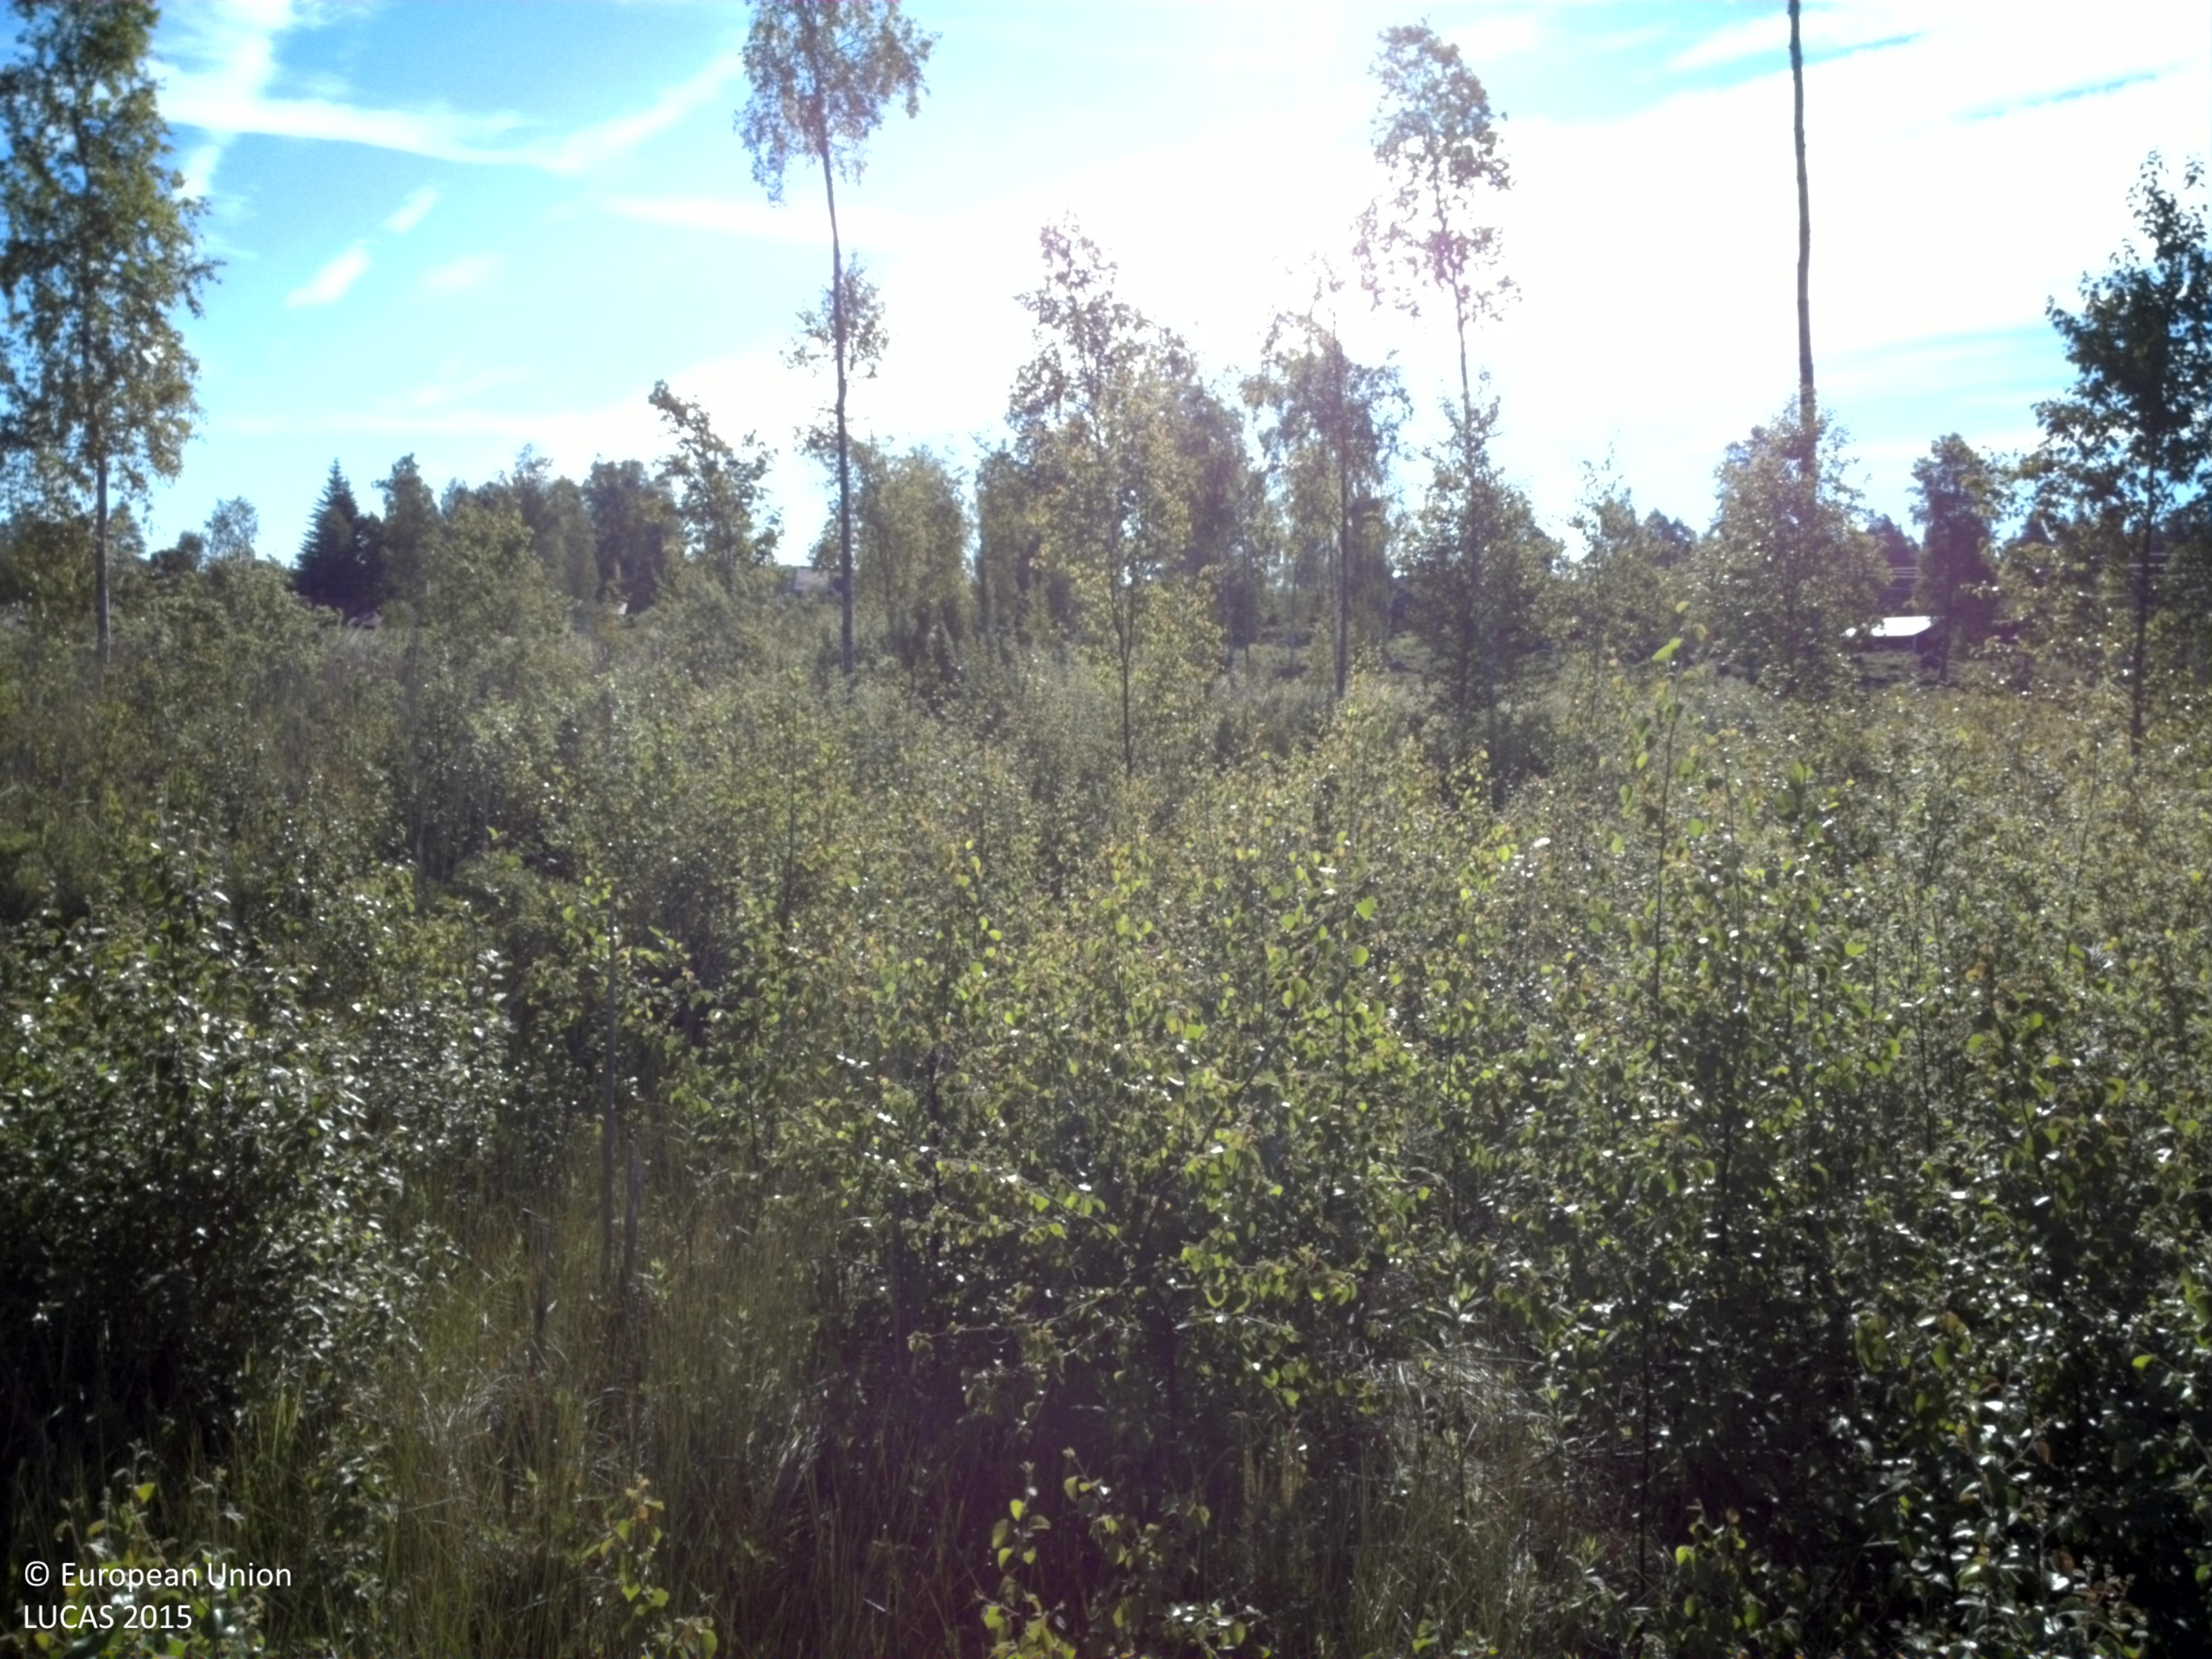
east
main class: Woodland
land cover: Broadleaved woodland
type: mire and swamp forests
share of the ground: > 75 %
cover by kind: broadleaved forest trees 90 %, coniferous forest trees 5 %, shrubs 5 %
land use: Forestry
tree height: < 5 m
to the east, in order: Broadleaved woodland; Inland marshes; Broadleaved woodland; Fences; Grassland with sparse tree/shrub cover; Fences; Broadleaved woodland; Artificial constructions in urban areas
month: June
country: SE
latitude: 58.4898
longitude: 14.4021
